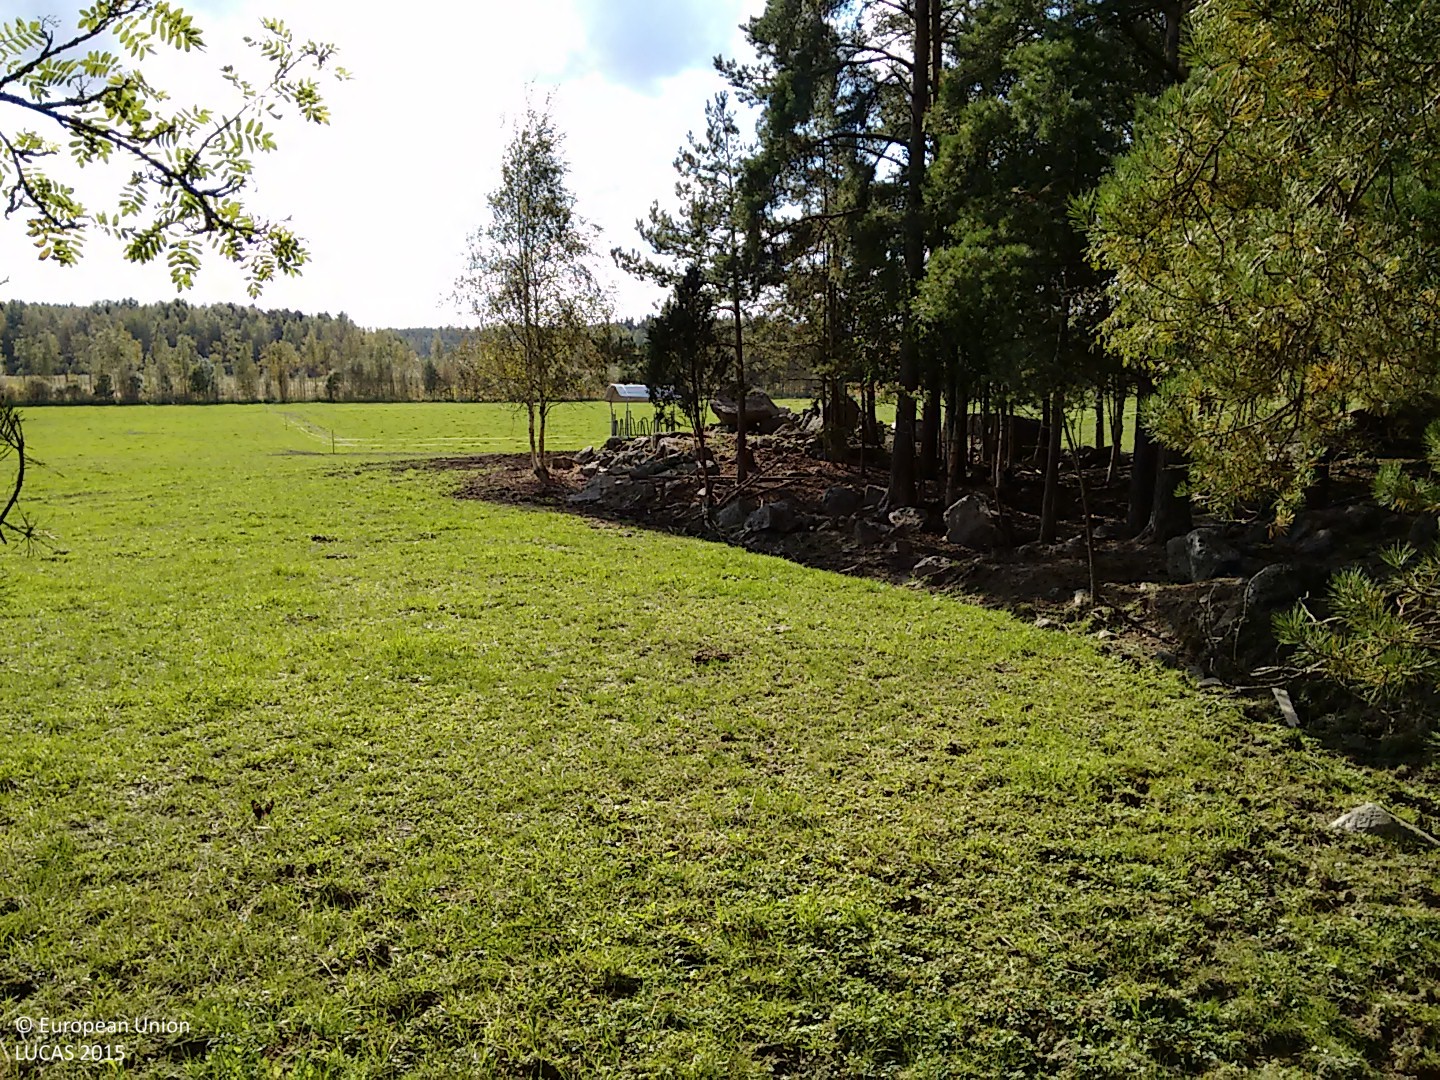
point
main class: Woodland
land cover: Pine dominated coniferous woodland
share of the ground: > 75 %
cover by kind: coniferous forest trees 80 %, unconsolidated bare surface 15 %, broadleaved forest trees 5 %
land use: Agriculture (excluding fallow land and kitchen gardens)
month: September
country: FI
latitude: 60.9702
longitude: 21.6759
